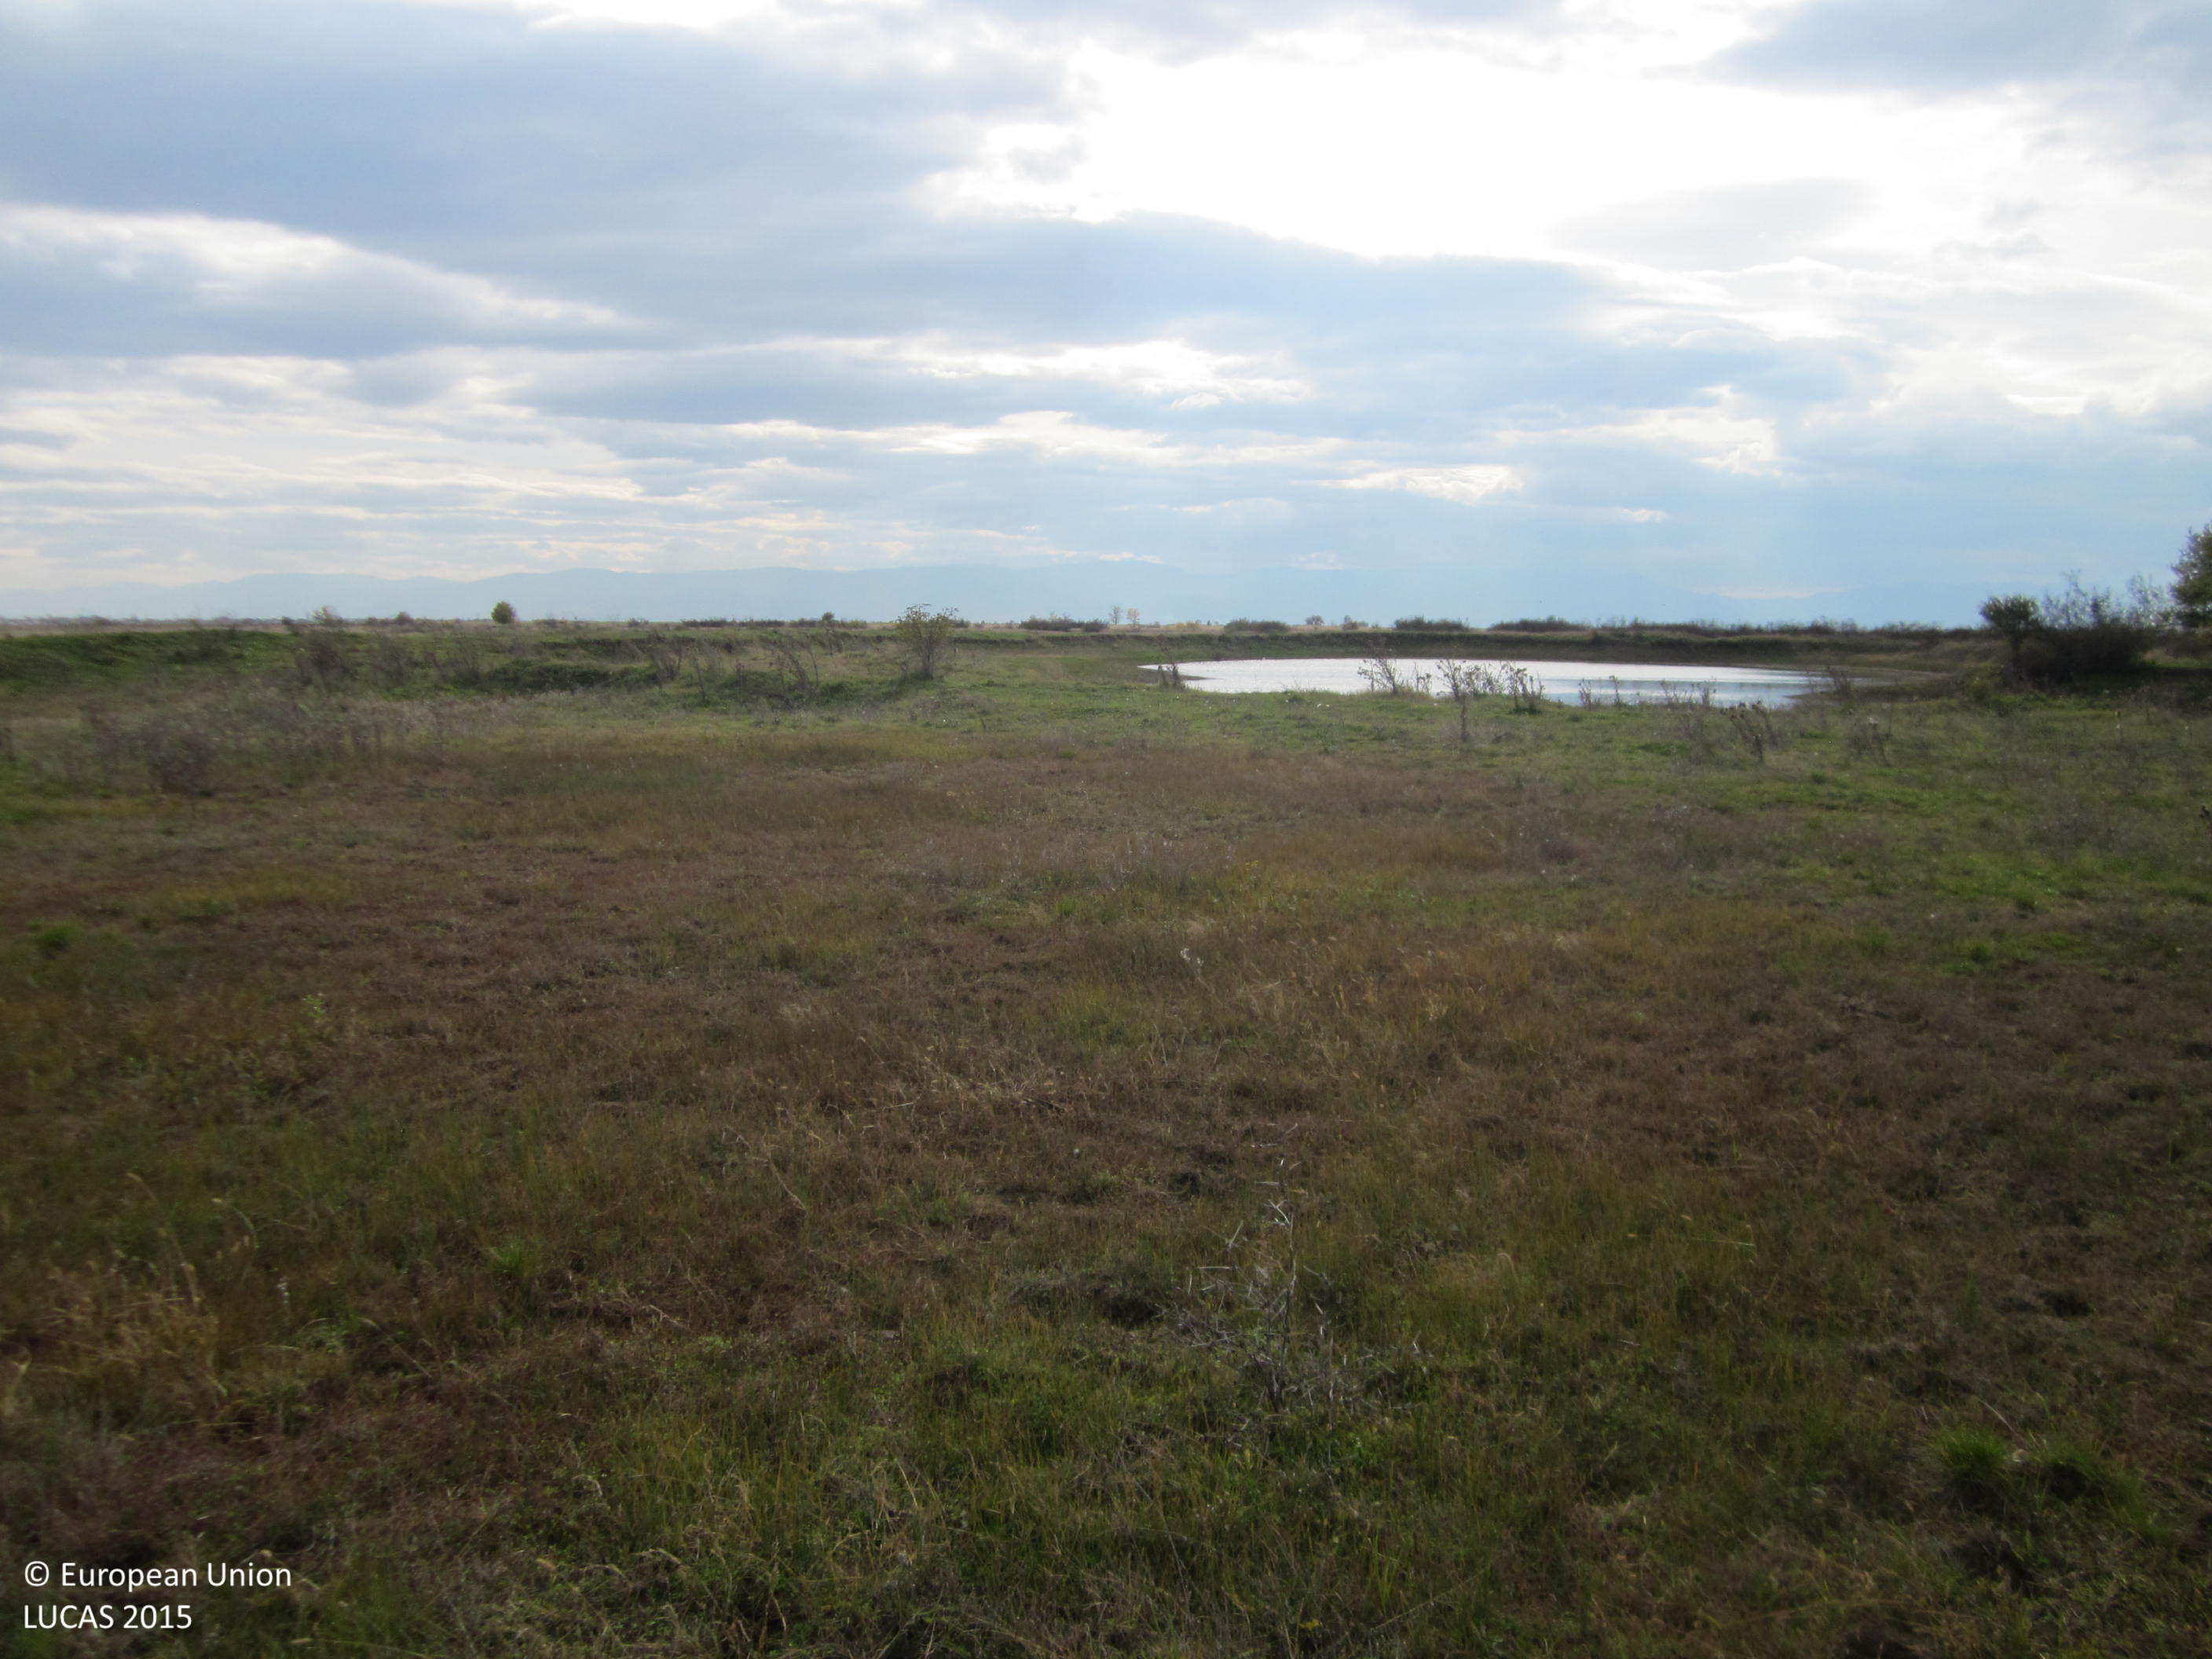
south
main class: Grassland
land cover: Grassland without tree/shrub cover
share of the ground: > 75 %
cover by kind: herbaceous plants 100 %
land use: Agriculture (excluding fallow land and kitchen gardens)
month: November
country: BG
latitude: 42.3402
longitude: 24.6042
